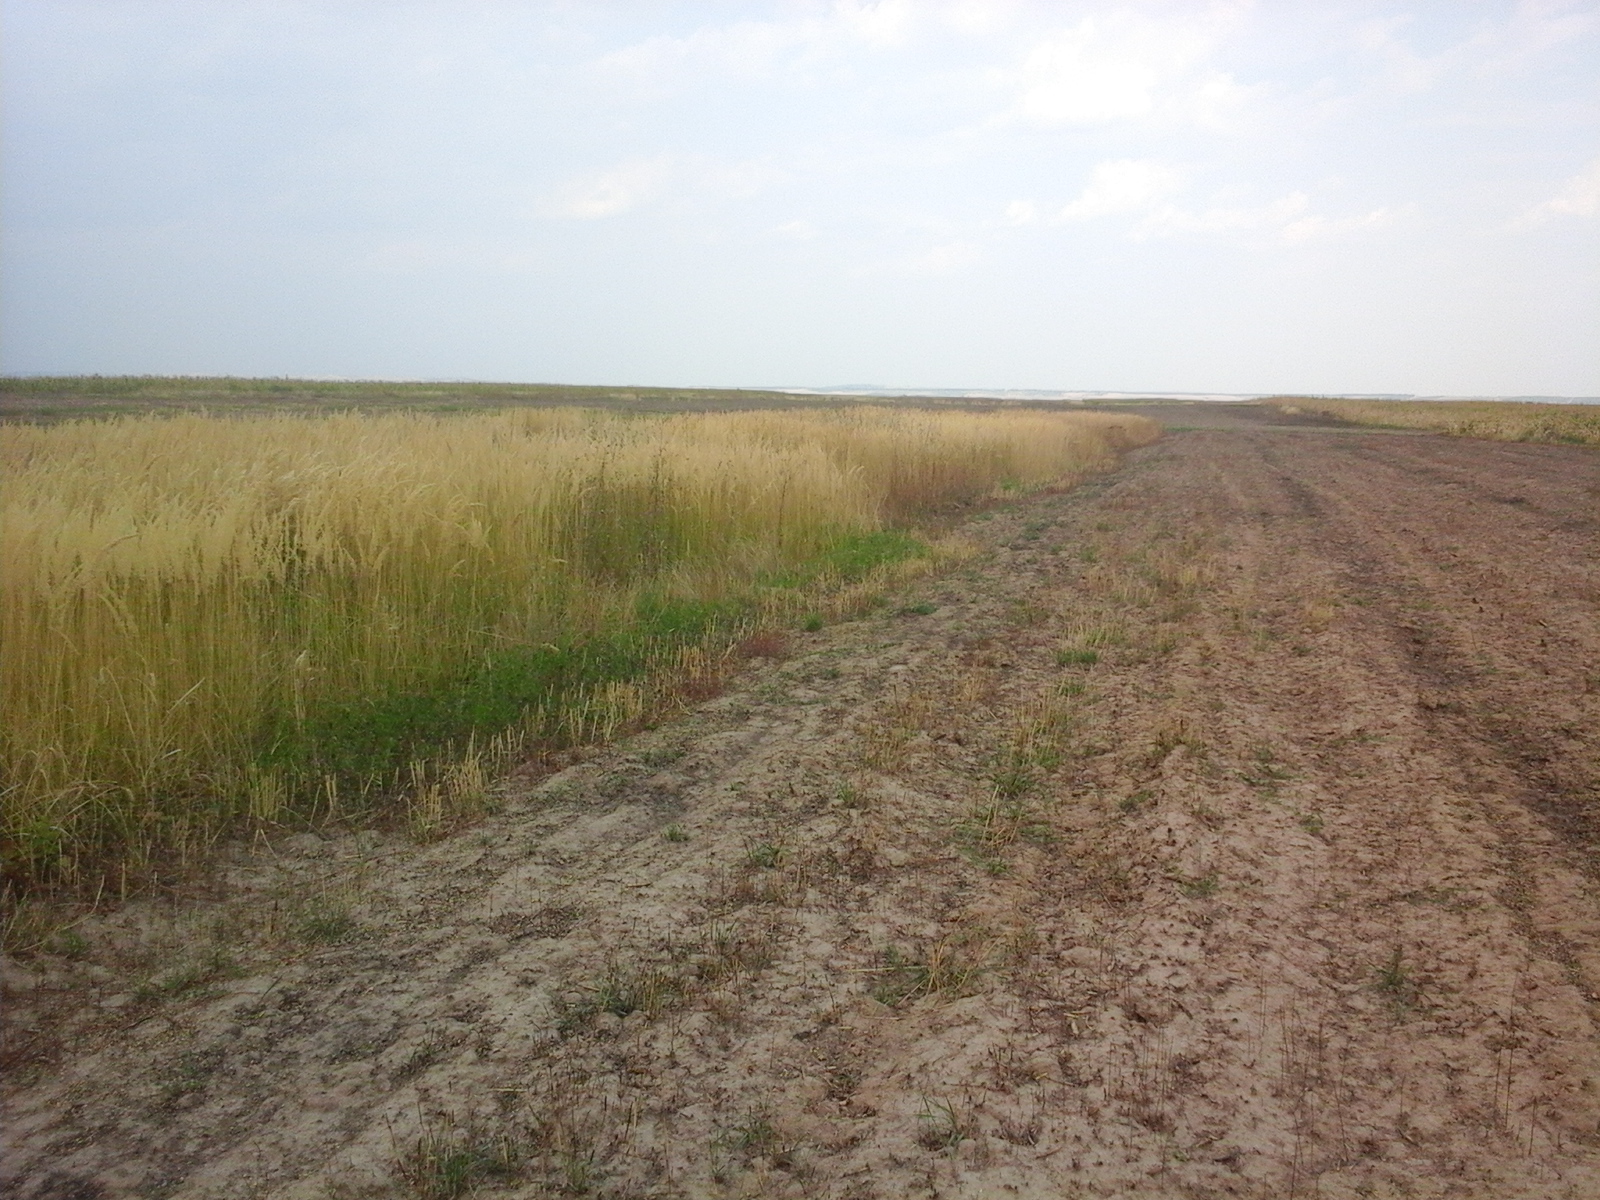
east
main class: Cropland
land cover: Durum wheat
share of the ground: < 10 %
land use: Agriculture (excluding fallow land and kitchen gardens)
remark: Burnt area
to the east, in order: Durum wheat; Spontaneously vegetated surfaces; Tracks; Spontaneously vegetated surfaces; Durum wheat; Tracks; Durum wheat
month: August
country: RO
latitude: 44.4014
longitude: 22.7348
